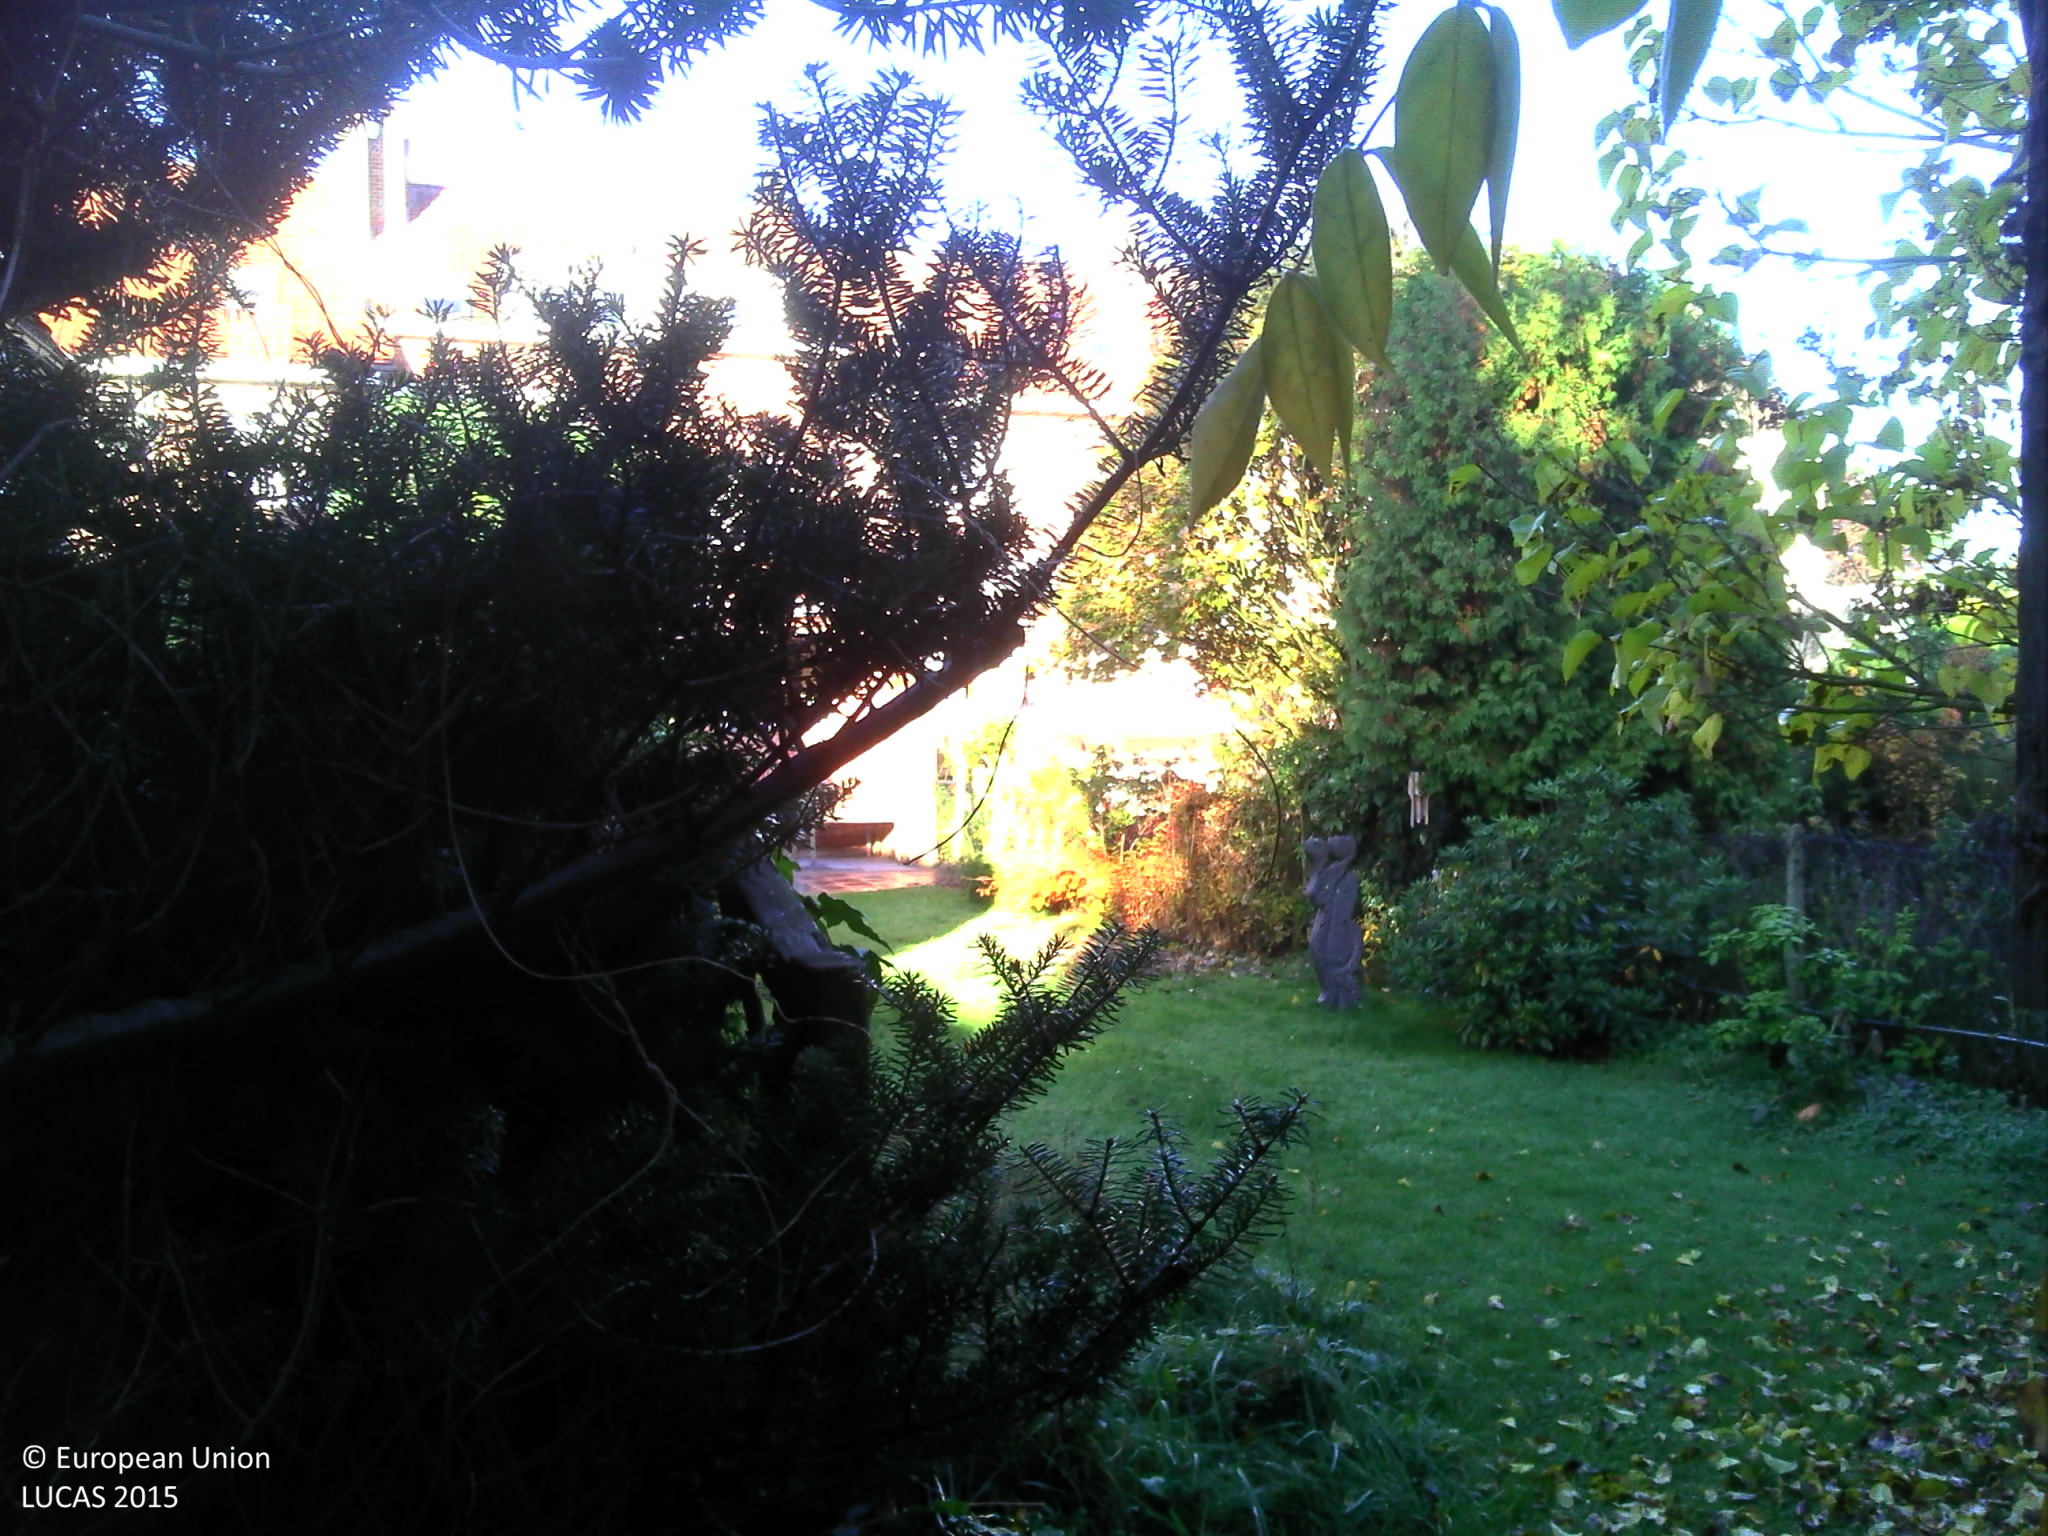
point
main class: Grassland
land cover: Grassland with sparse tree/shrub cover
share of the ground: > 75 %
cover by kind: herbaceous plants 85 %, shrubs 10 %, coniferous forest trees 5 %
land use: Residential
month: October
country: BE
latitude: 50.8432
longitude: 4.4712
